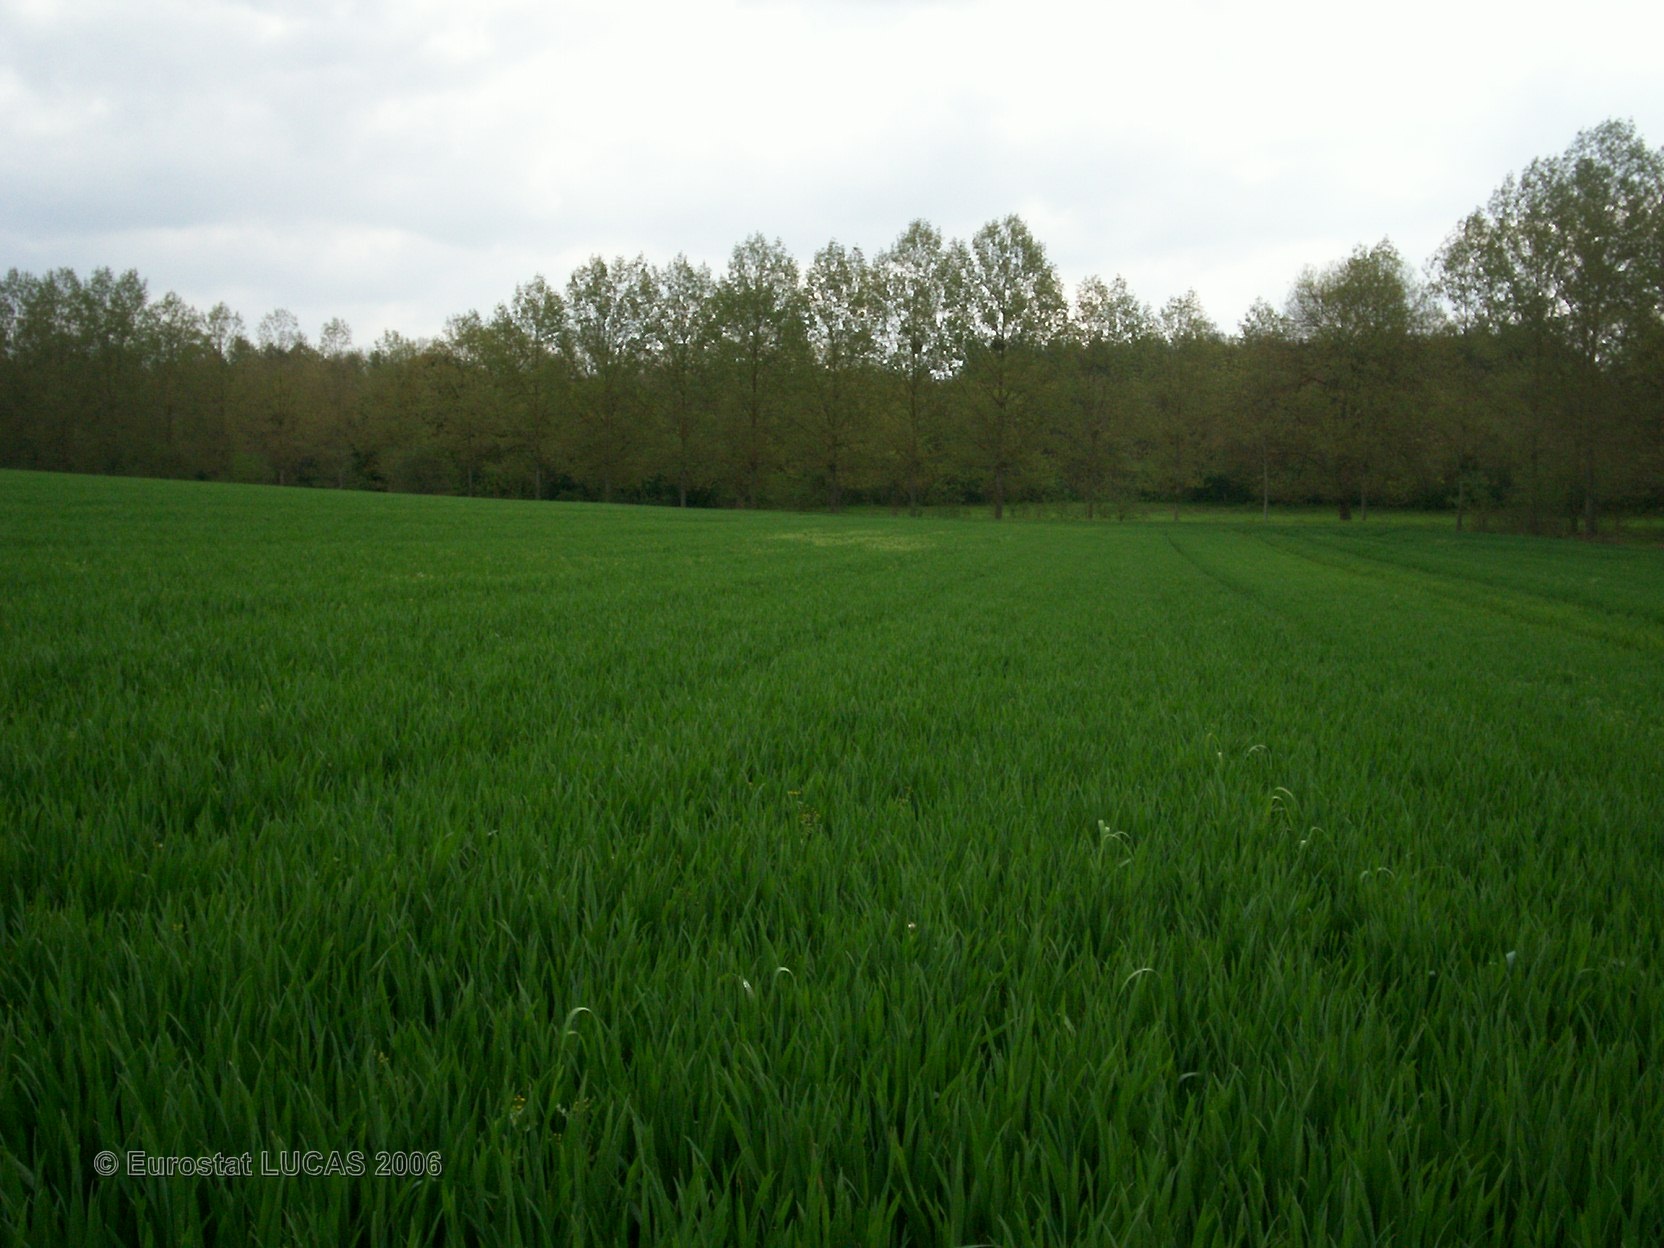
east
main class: Cropland
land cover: Common wheat
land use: Agriculture (excluding fallow land and kitchen gardens)
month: April
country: FR
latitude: 47.0472
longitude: -0.3337
